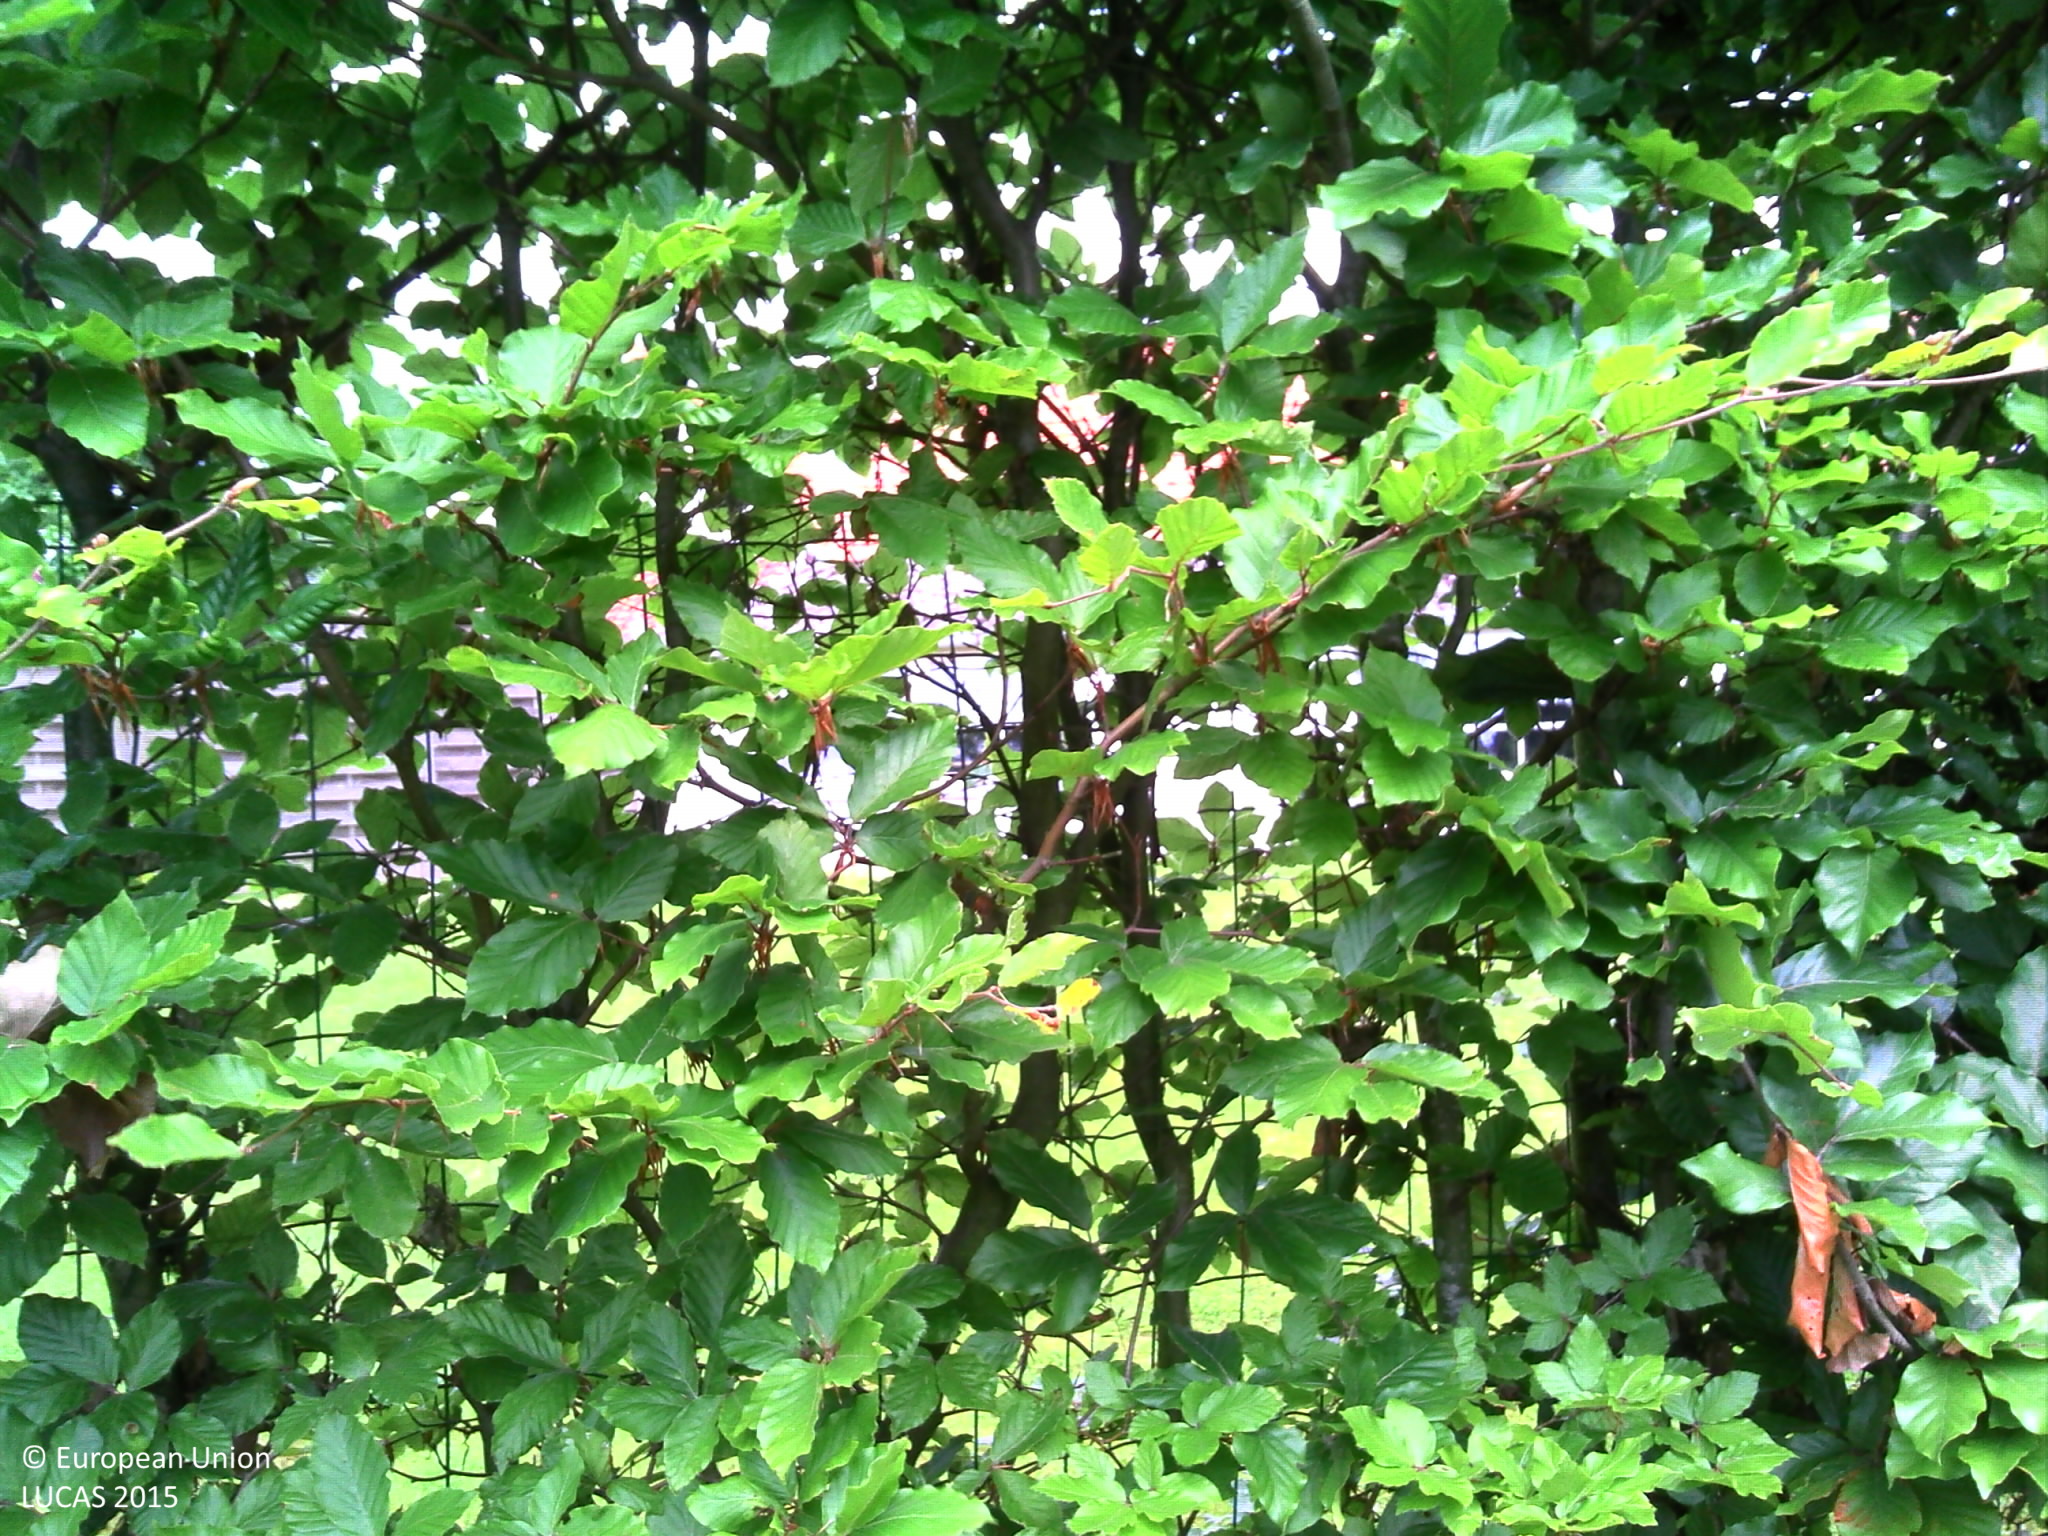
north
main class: Grassland
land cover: Grassland without tree/shrub cover
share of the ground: > 75 %
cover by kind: herbaceous plants 100 %
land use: Residential
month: June
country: BE
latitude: 50.8825
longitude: 3.4965
